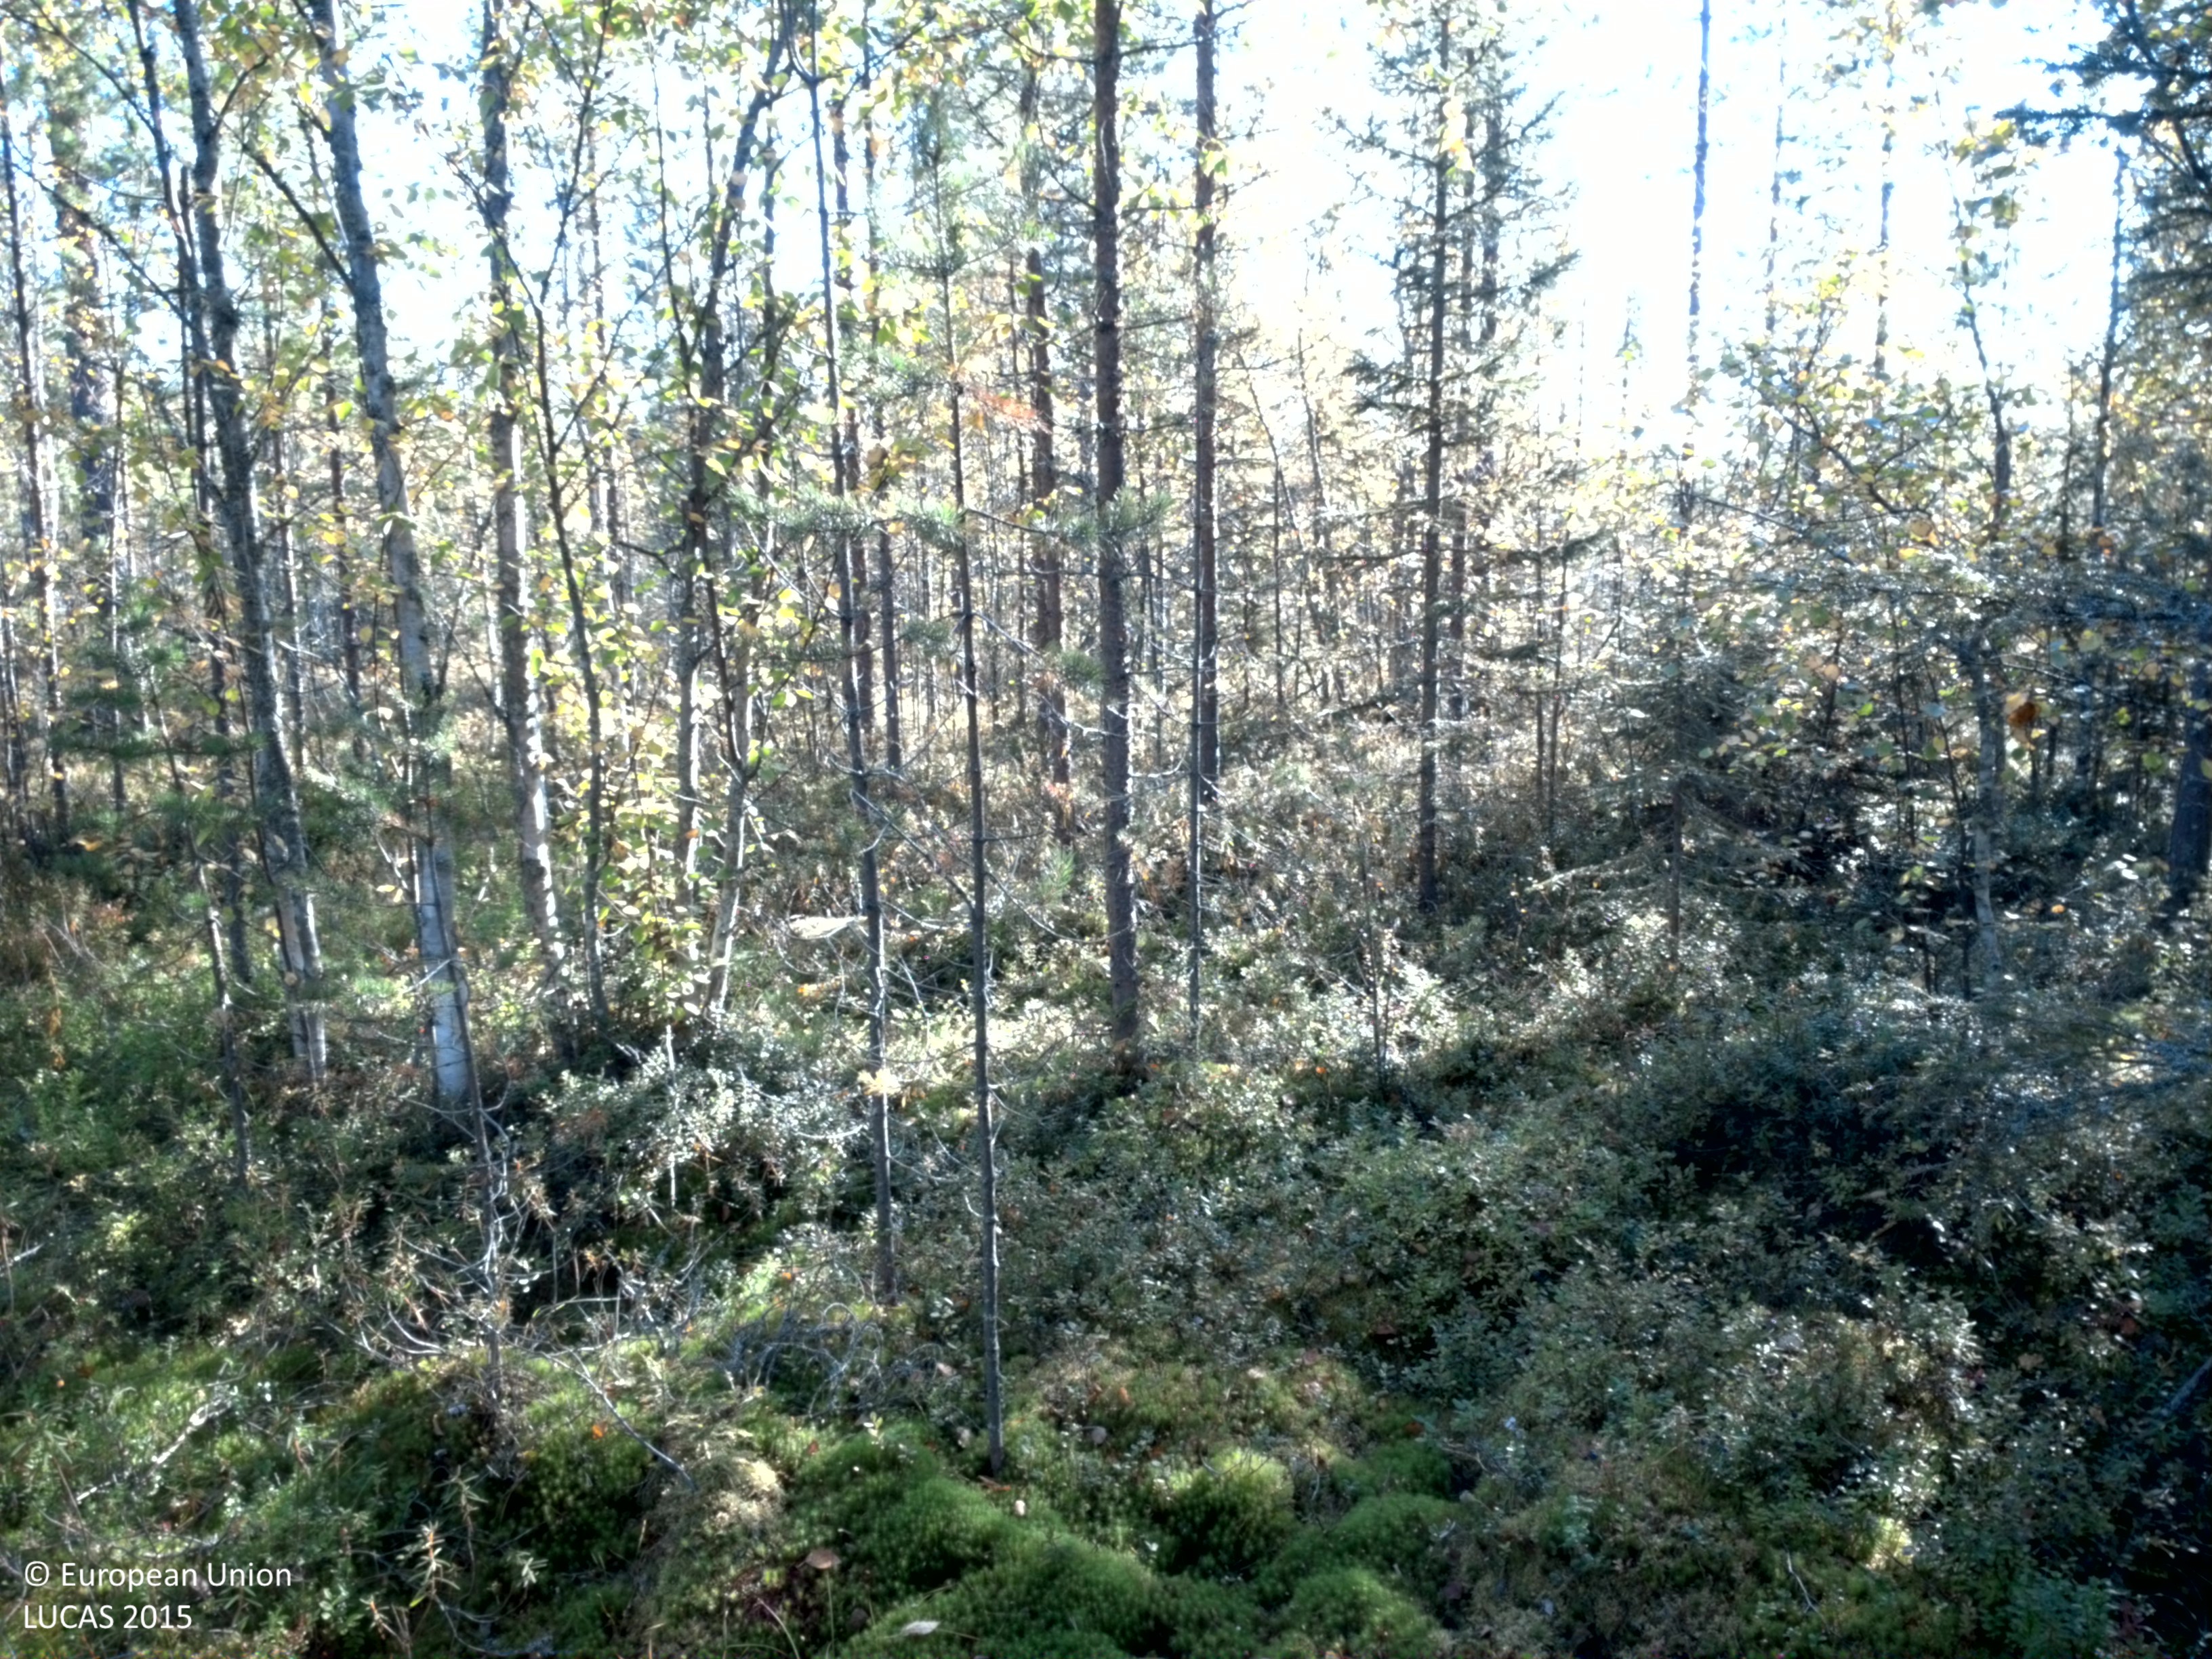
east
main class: Woodland
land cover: Pine dominated mixed woodland
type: boreal forest
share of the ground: 25 - 50 %
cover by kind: shrubs 60 %, coniferous forest trees 25 %, broadleaved forest trees 10 %, lichens and mosses 5 %
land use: Forestry
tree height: > 5 m
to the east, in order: Pine dominated mixed woodland; Pine dominated coniferous woodland
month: September
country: SE
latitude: 65.8523
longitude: 22.1787
